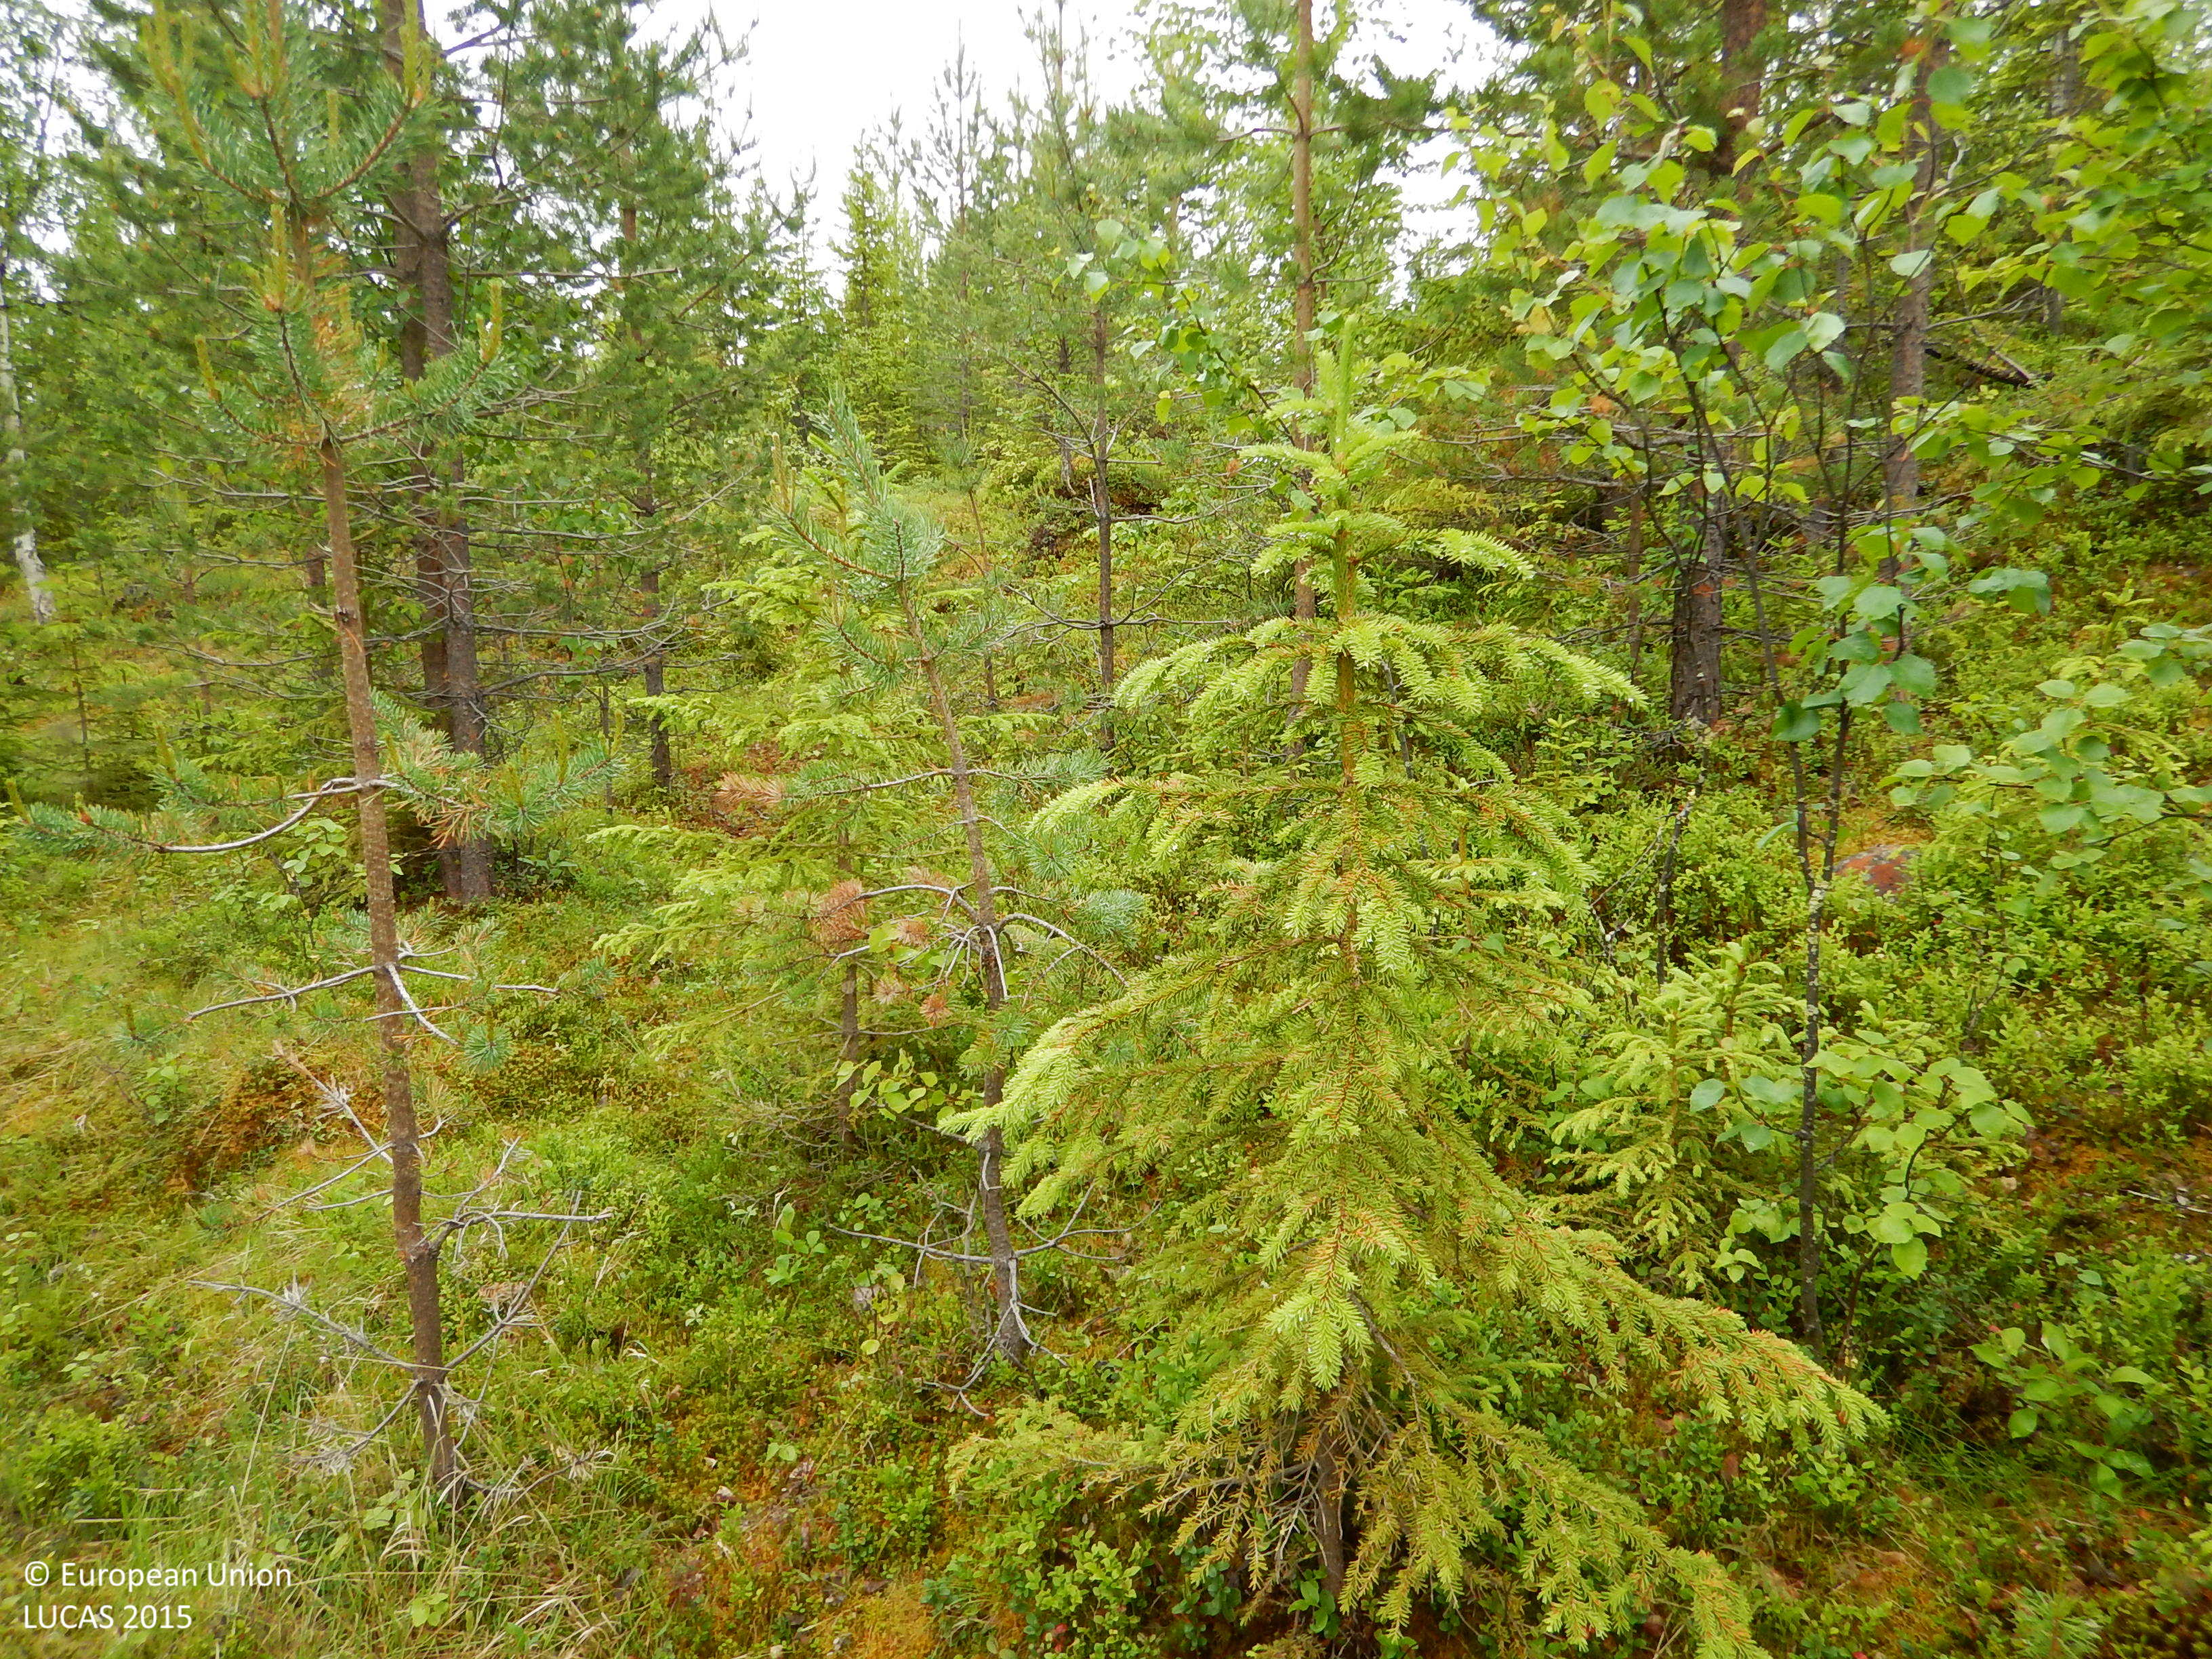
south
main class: Woodland
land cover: Pine dominated mixed woodland
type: boreal forest
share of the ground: 25 - 50 %
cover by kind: herbaceous plants 40 %, lichens and mosses 25 %, coniferous forest trees 20 %, broadleaved forest trees 10 %, shrubs 5 %
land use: Forestry
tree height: < 5 m
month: July
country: SE
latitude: 65.1626
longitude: 18.6471
